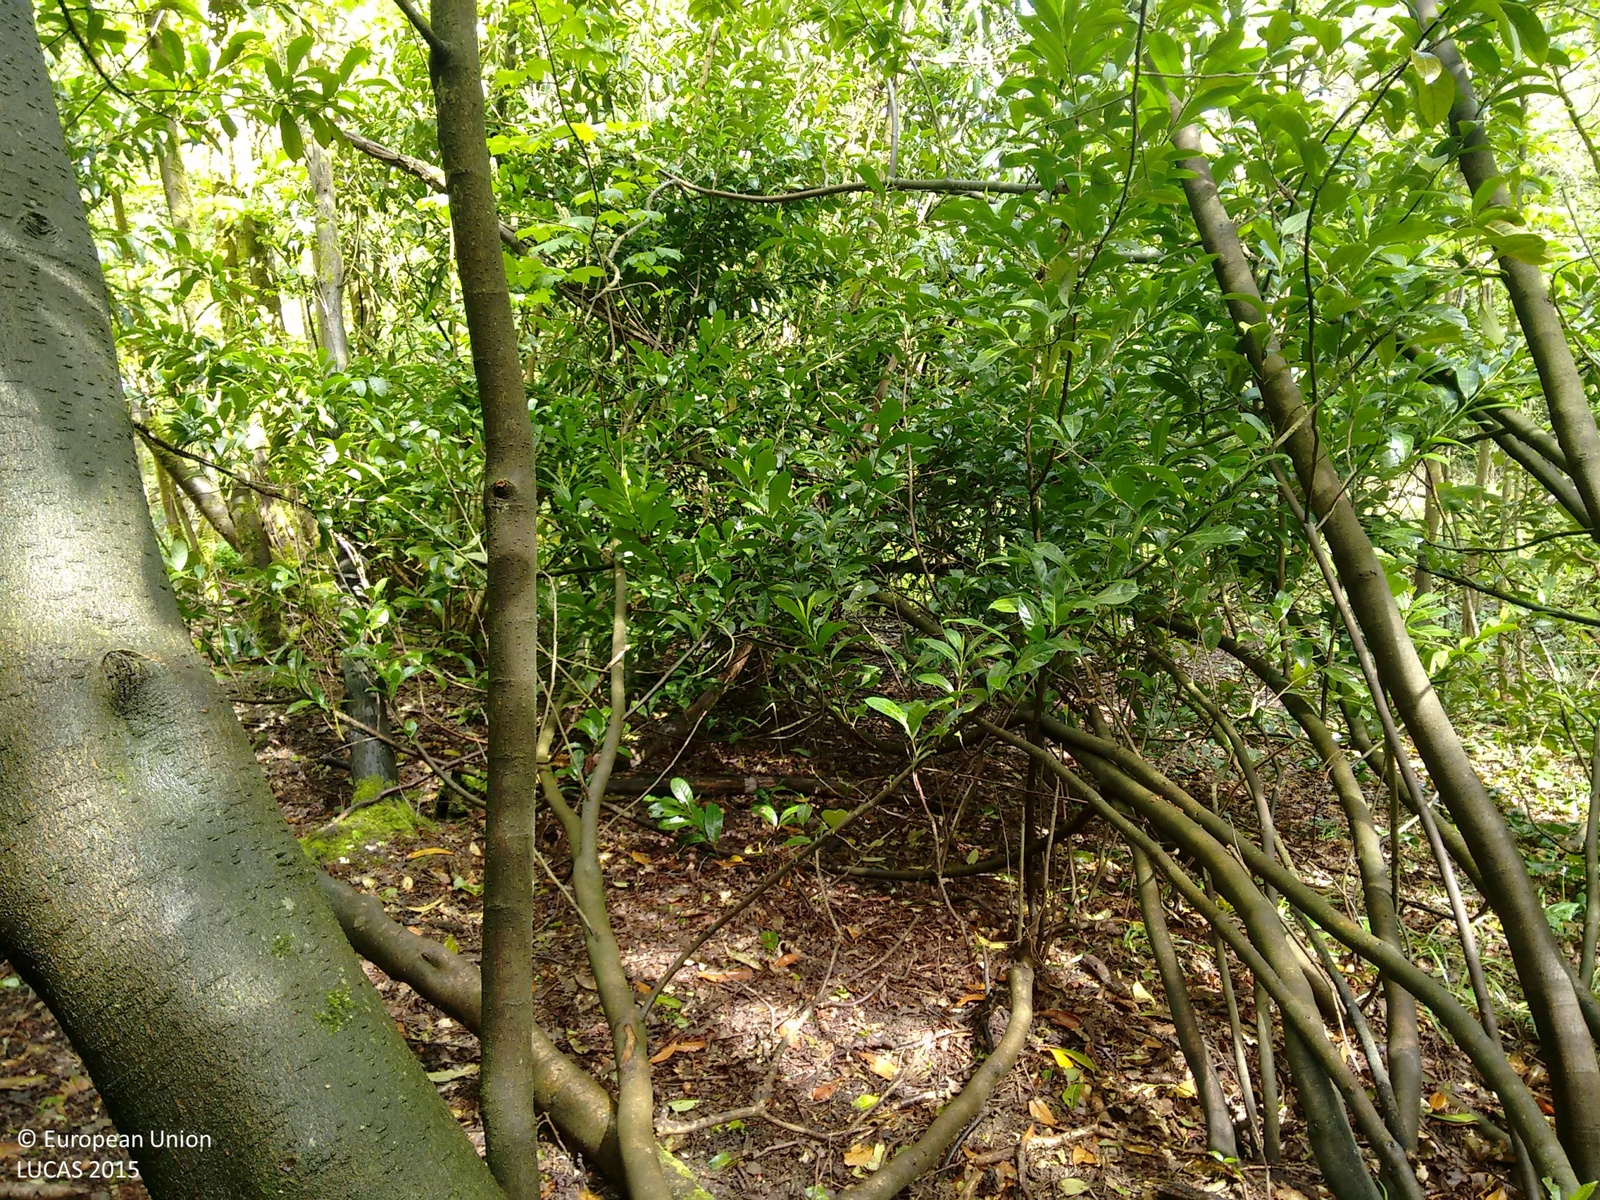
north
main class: Woodland
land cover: Broadleaved woodland
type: mesophytic deciduous forest
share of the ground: > 75 %
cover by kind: broadleaved forest trees 100 %
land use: Forestry
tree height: > 5 m
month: May
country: GB
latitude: 51.3115
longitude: 0.1124
